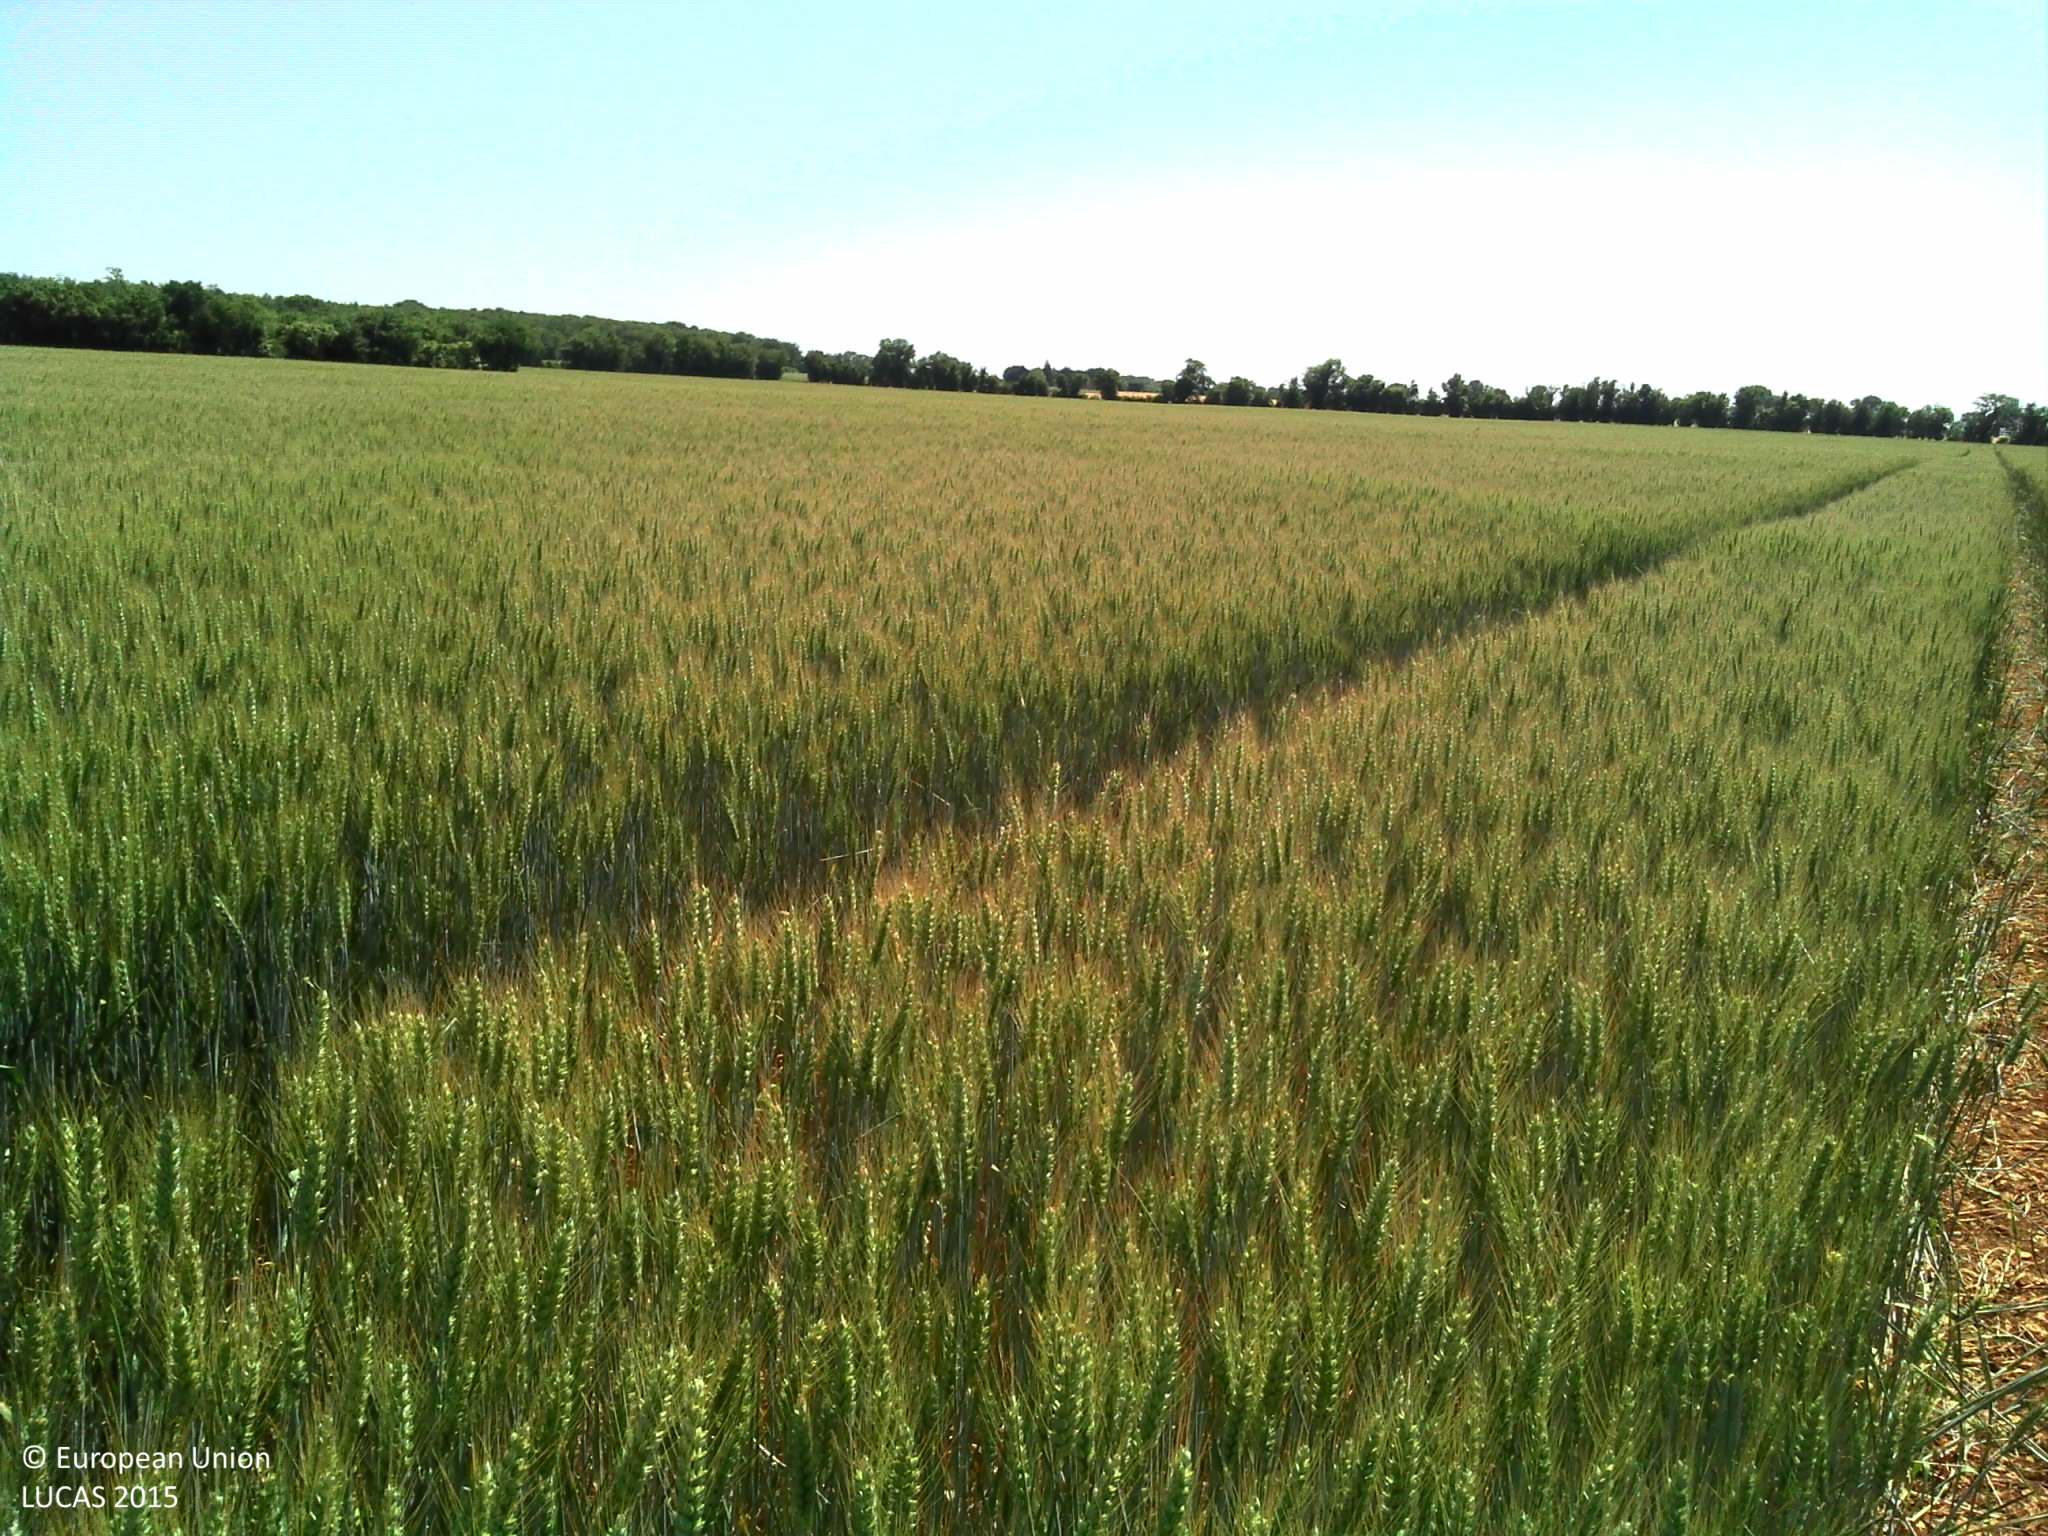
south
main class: Cropland
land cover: Common wheat
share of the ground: > 75 %
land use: Agriculture (excluding fallow land and kitchen gardens)
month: June
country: FR
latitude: 46.8798
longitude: 2.7122
